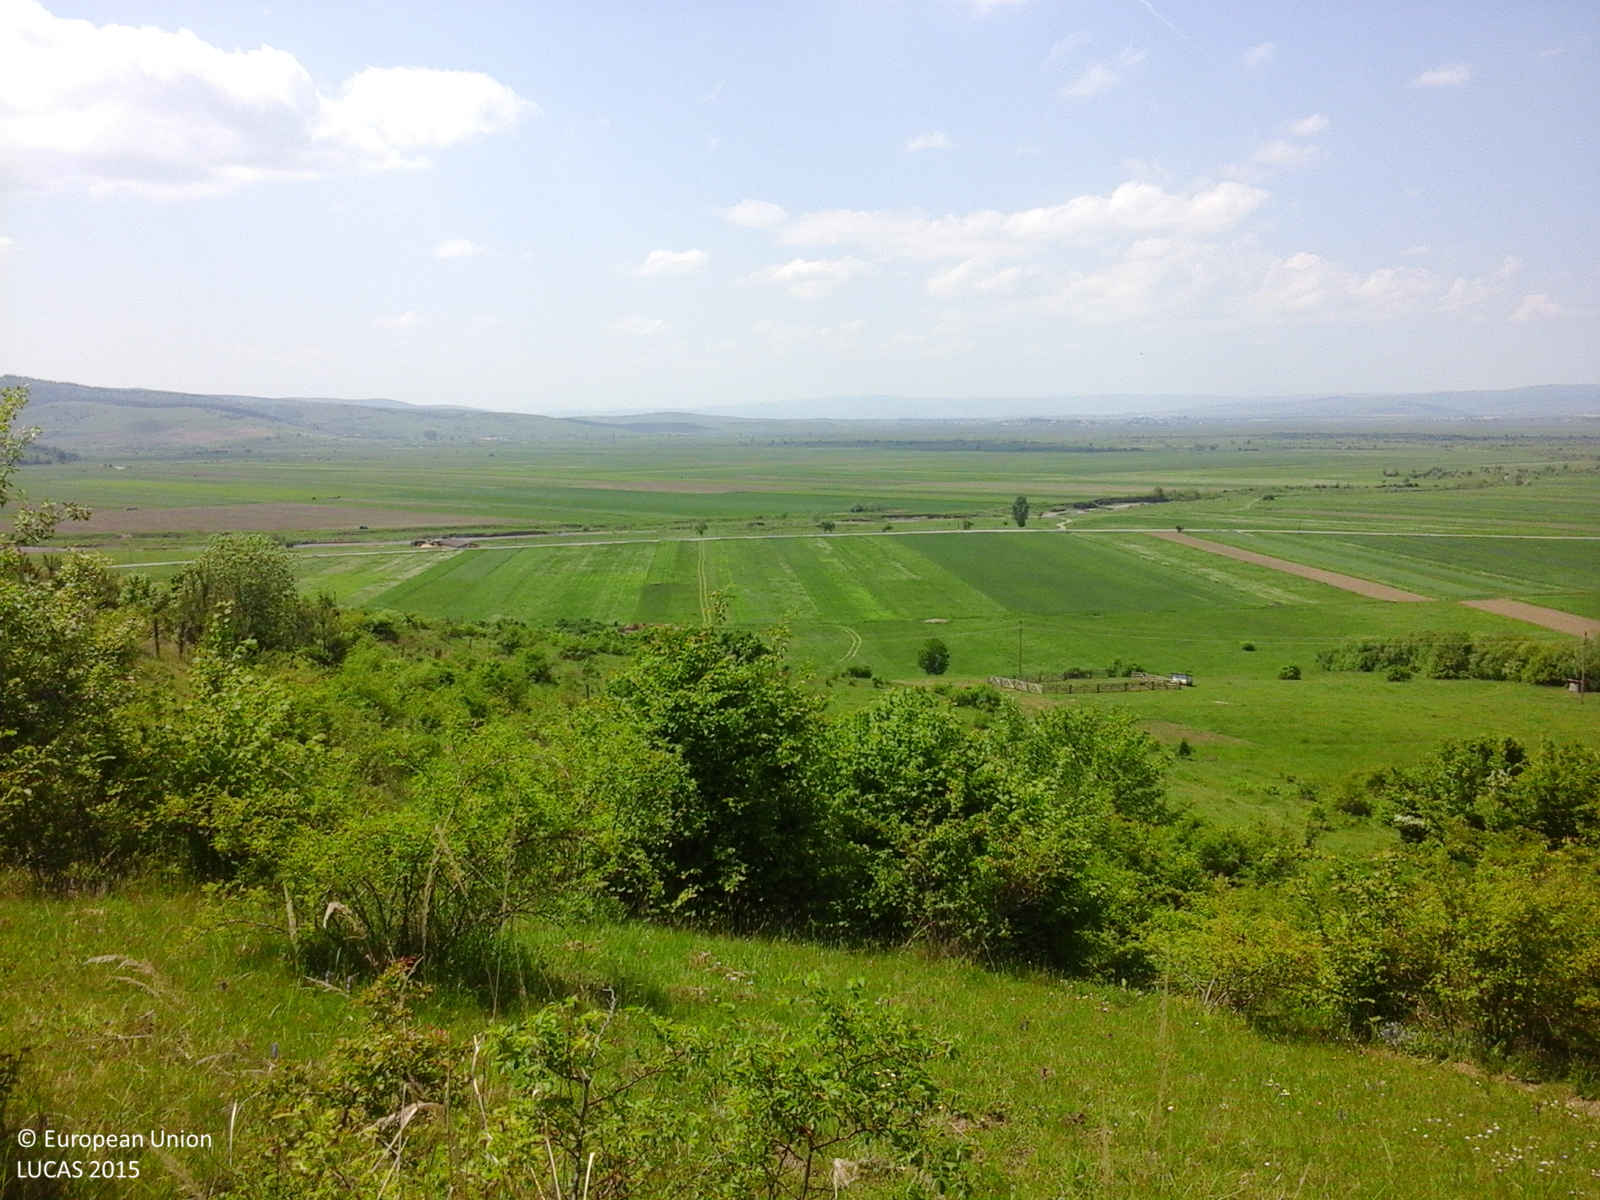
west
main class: Shrubland
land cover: Shrubland with sparse tree cover
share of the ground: > 75 %
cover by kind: shrubs 75 %, herbaceous plants 20 %, broadleaved forest trees 5 %
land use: Forestry
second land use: Agriculture (excluding fallow land and kitchen gardens)
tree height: < 5 m
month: May
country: RO
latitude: 45.7813
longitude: 26.1051
